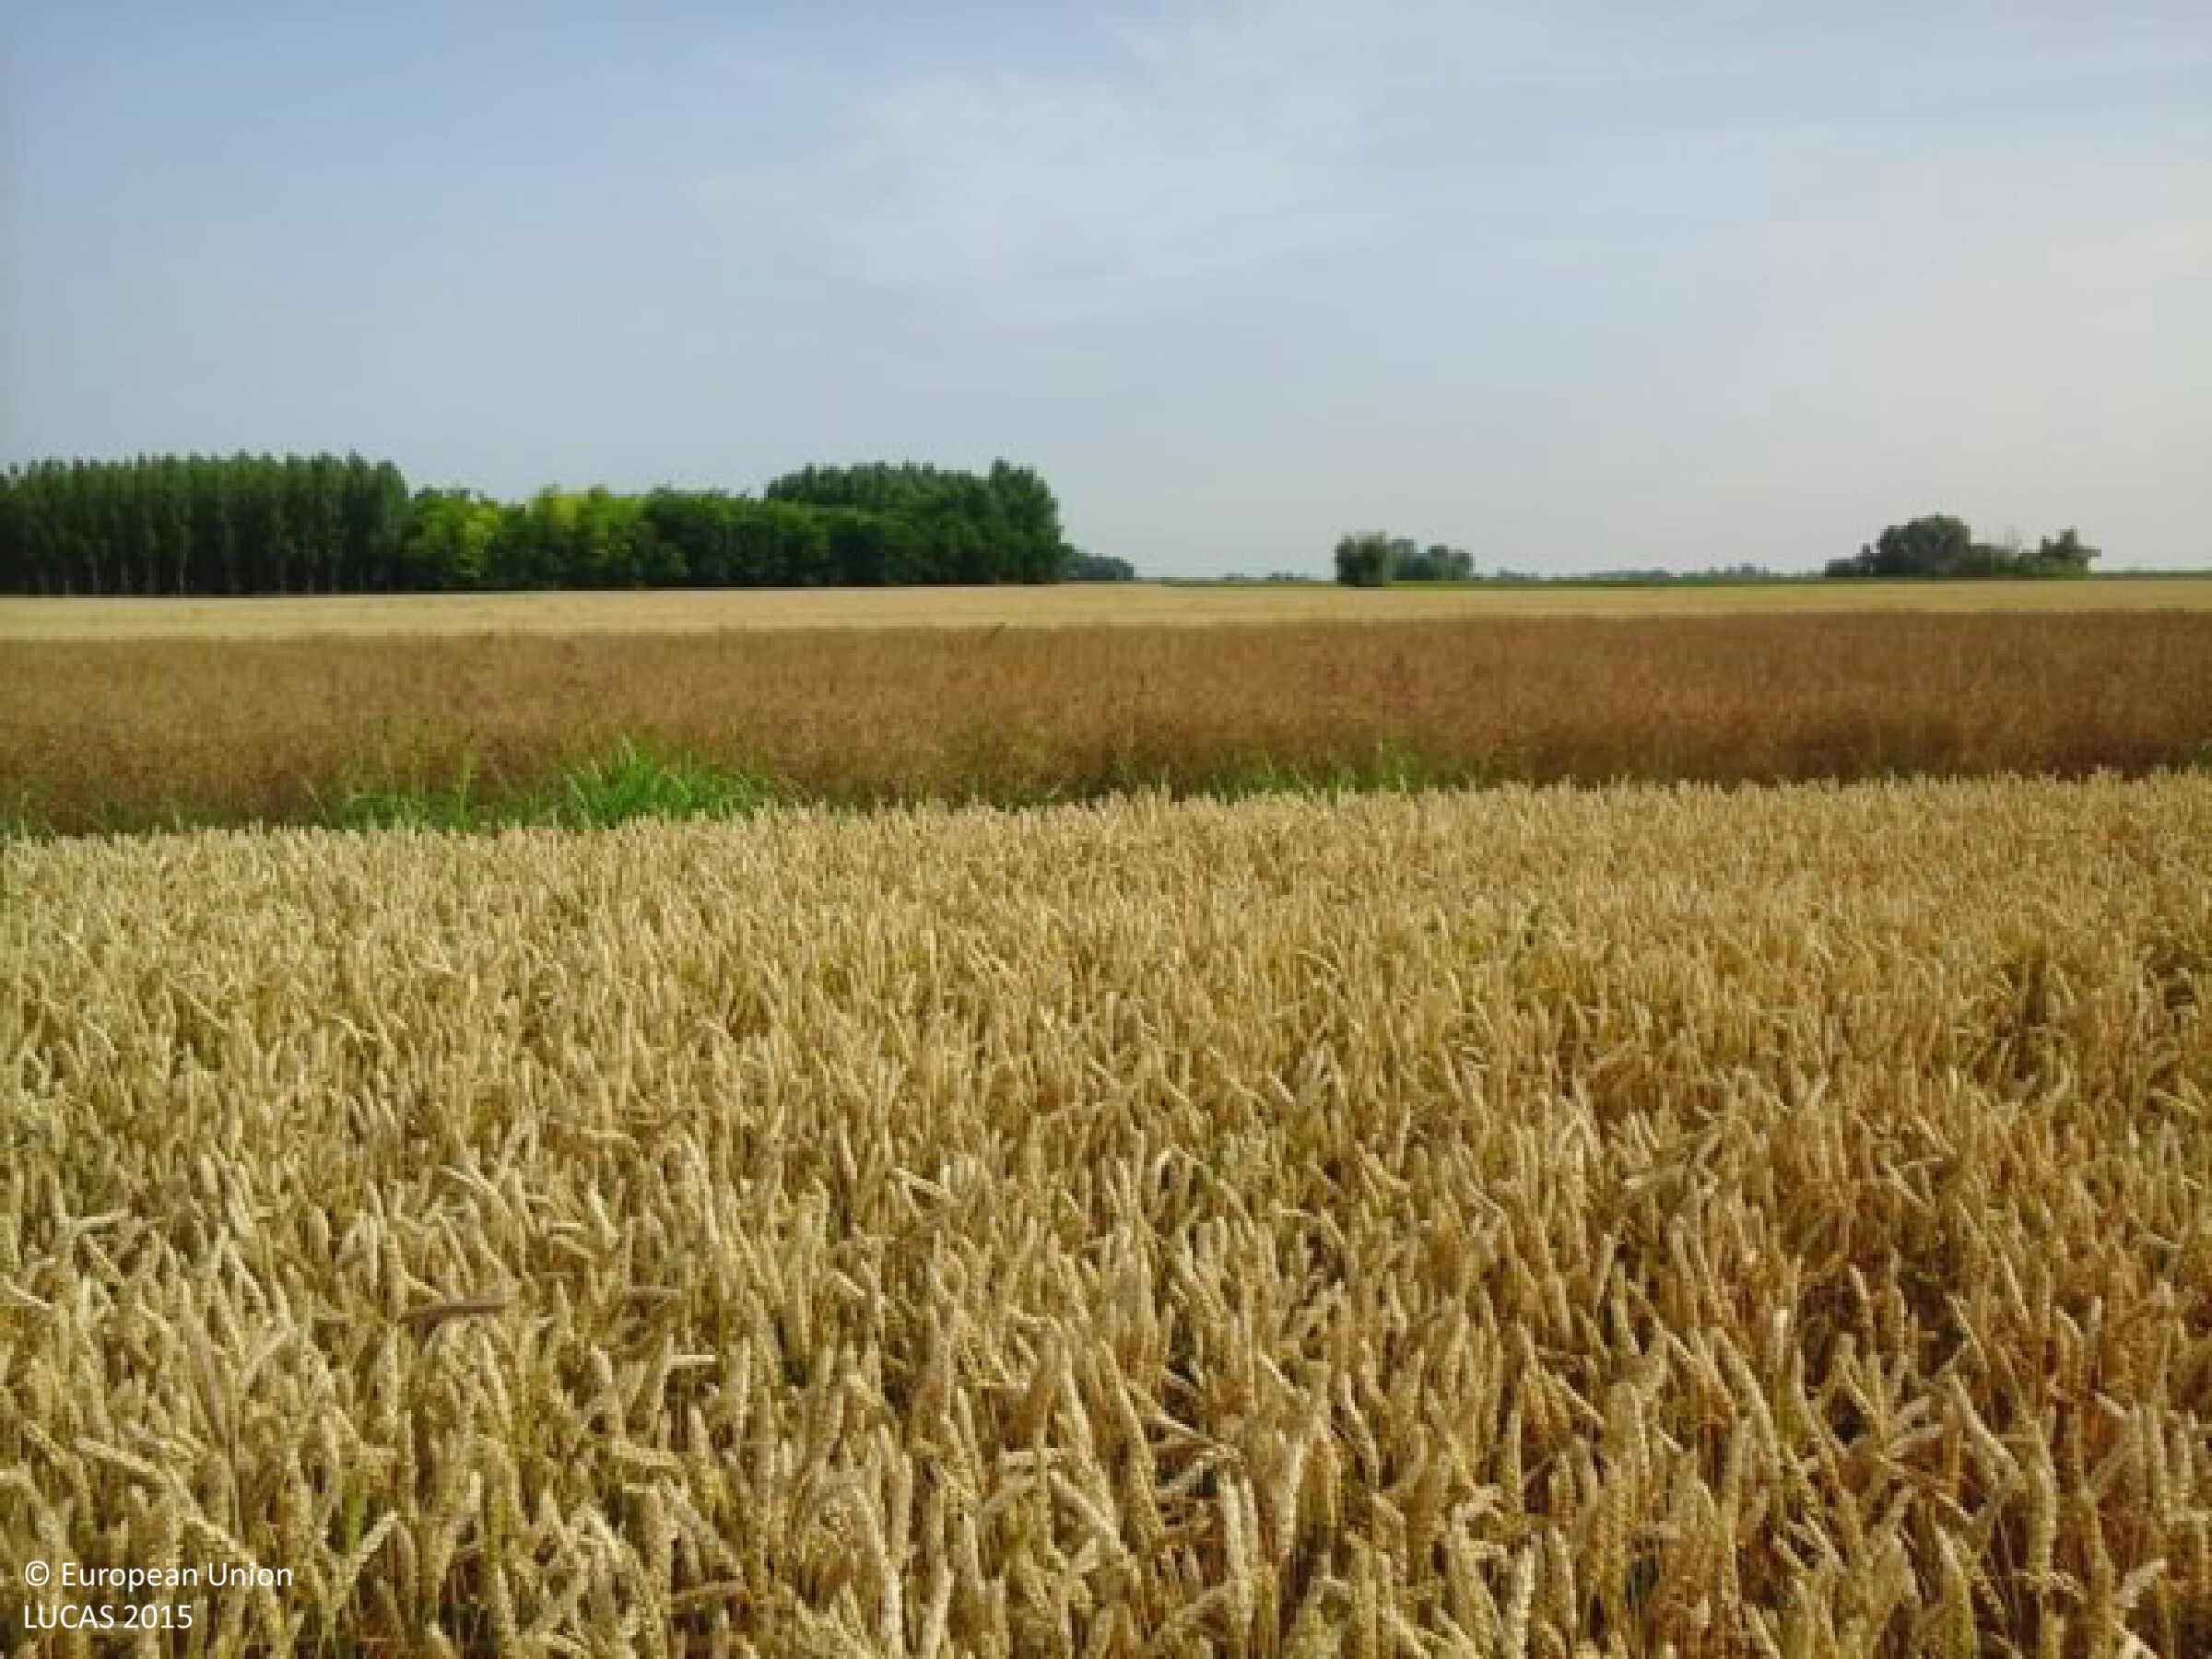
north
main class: Cropland
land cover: Common wheat
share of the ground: > 75 %
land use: Agriculture (excluding fallow land and kitchen gardens)
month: June
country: HU
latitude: 46.3723
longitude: 18.9698
